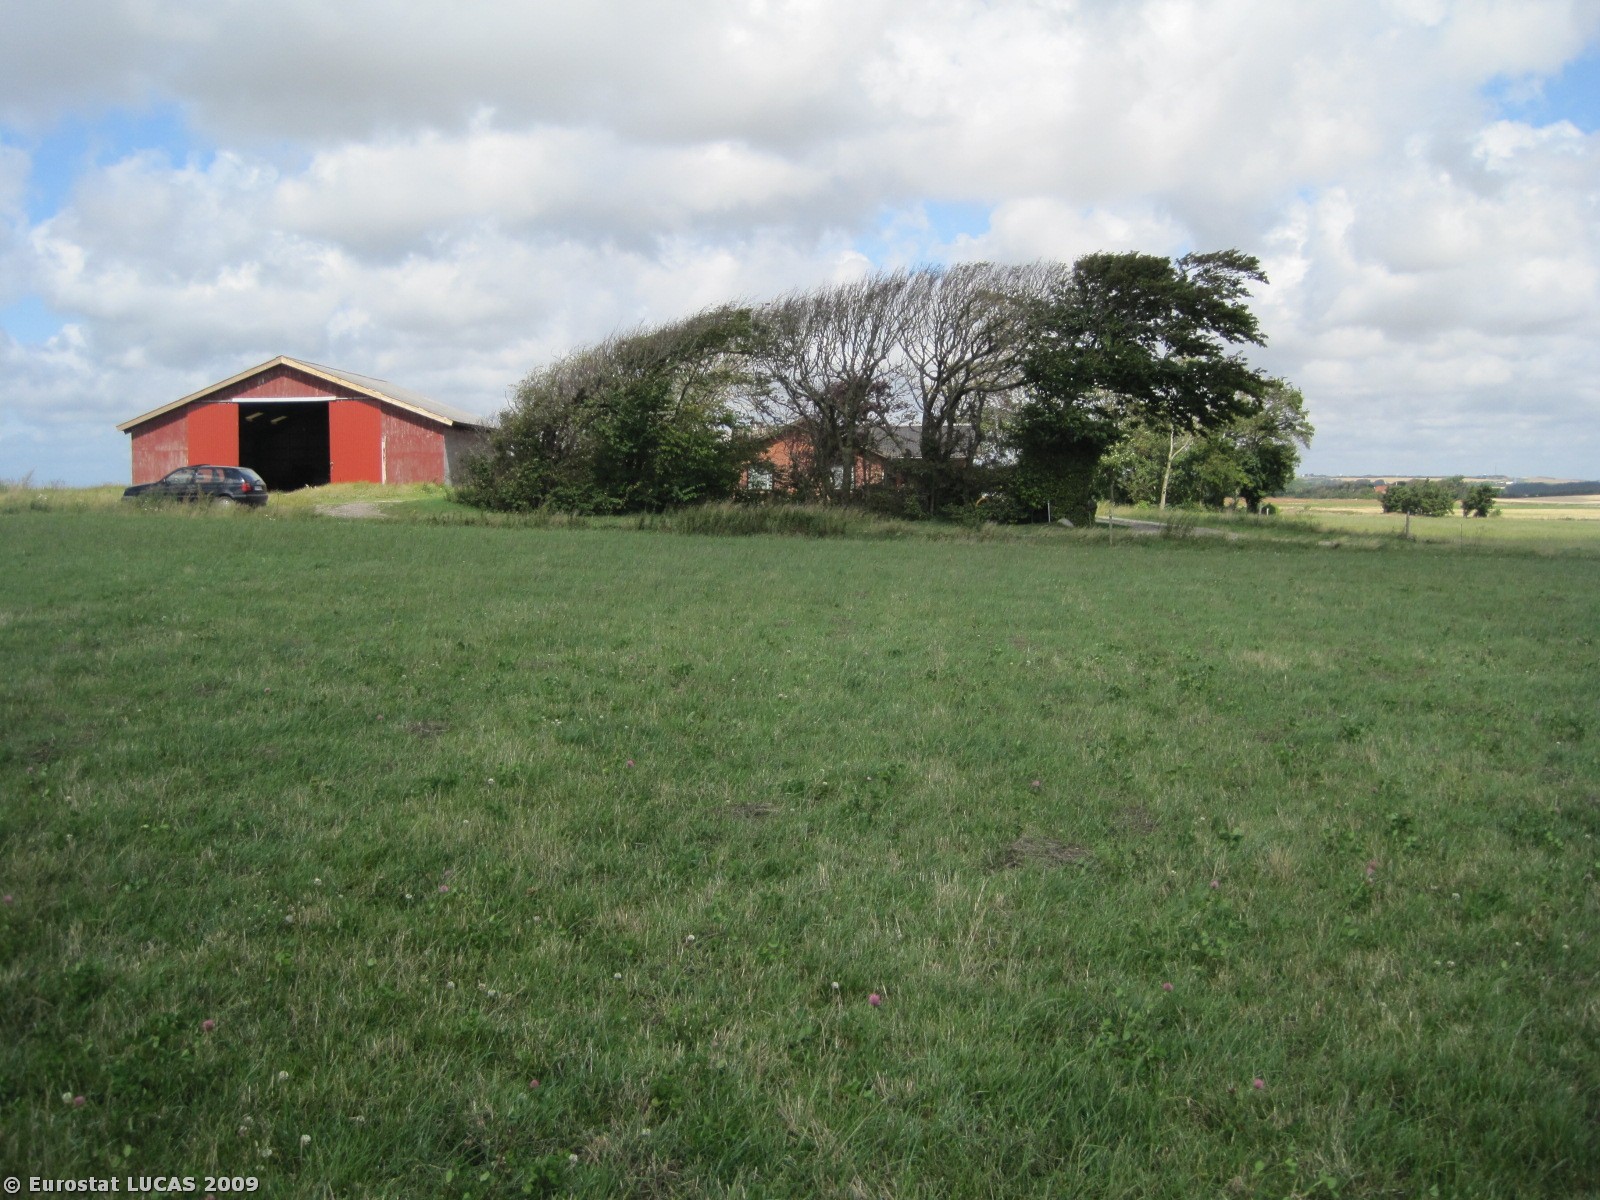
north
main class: Grassland
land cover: Grassland without tree/shrub cover
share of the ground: > 75 %
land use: Agriculture (excluding fallow land and kitchen gardens)
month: July
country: DK
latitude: 56.8252
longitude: 8.4127
